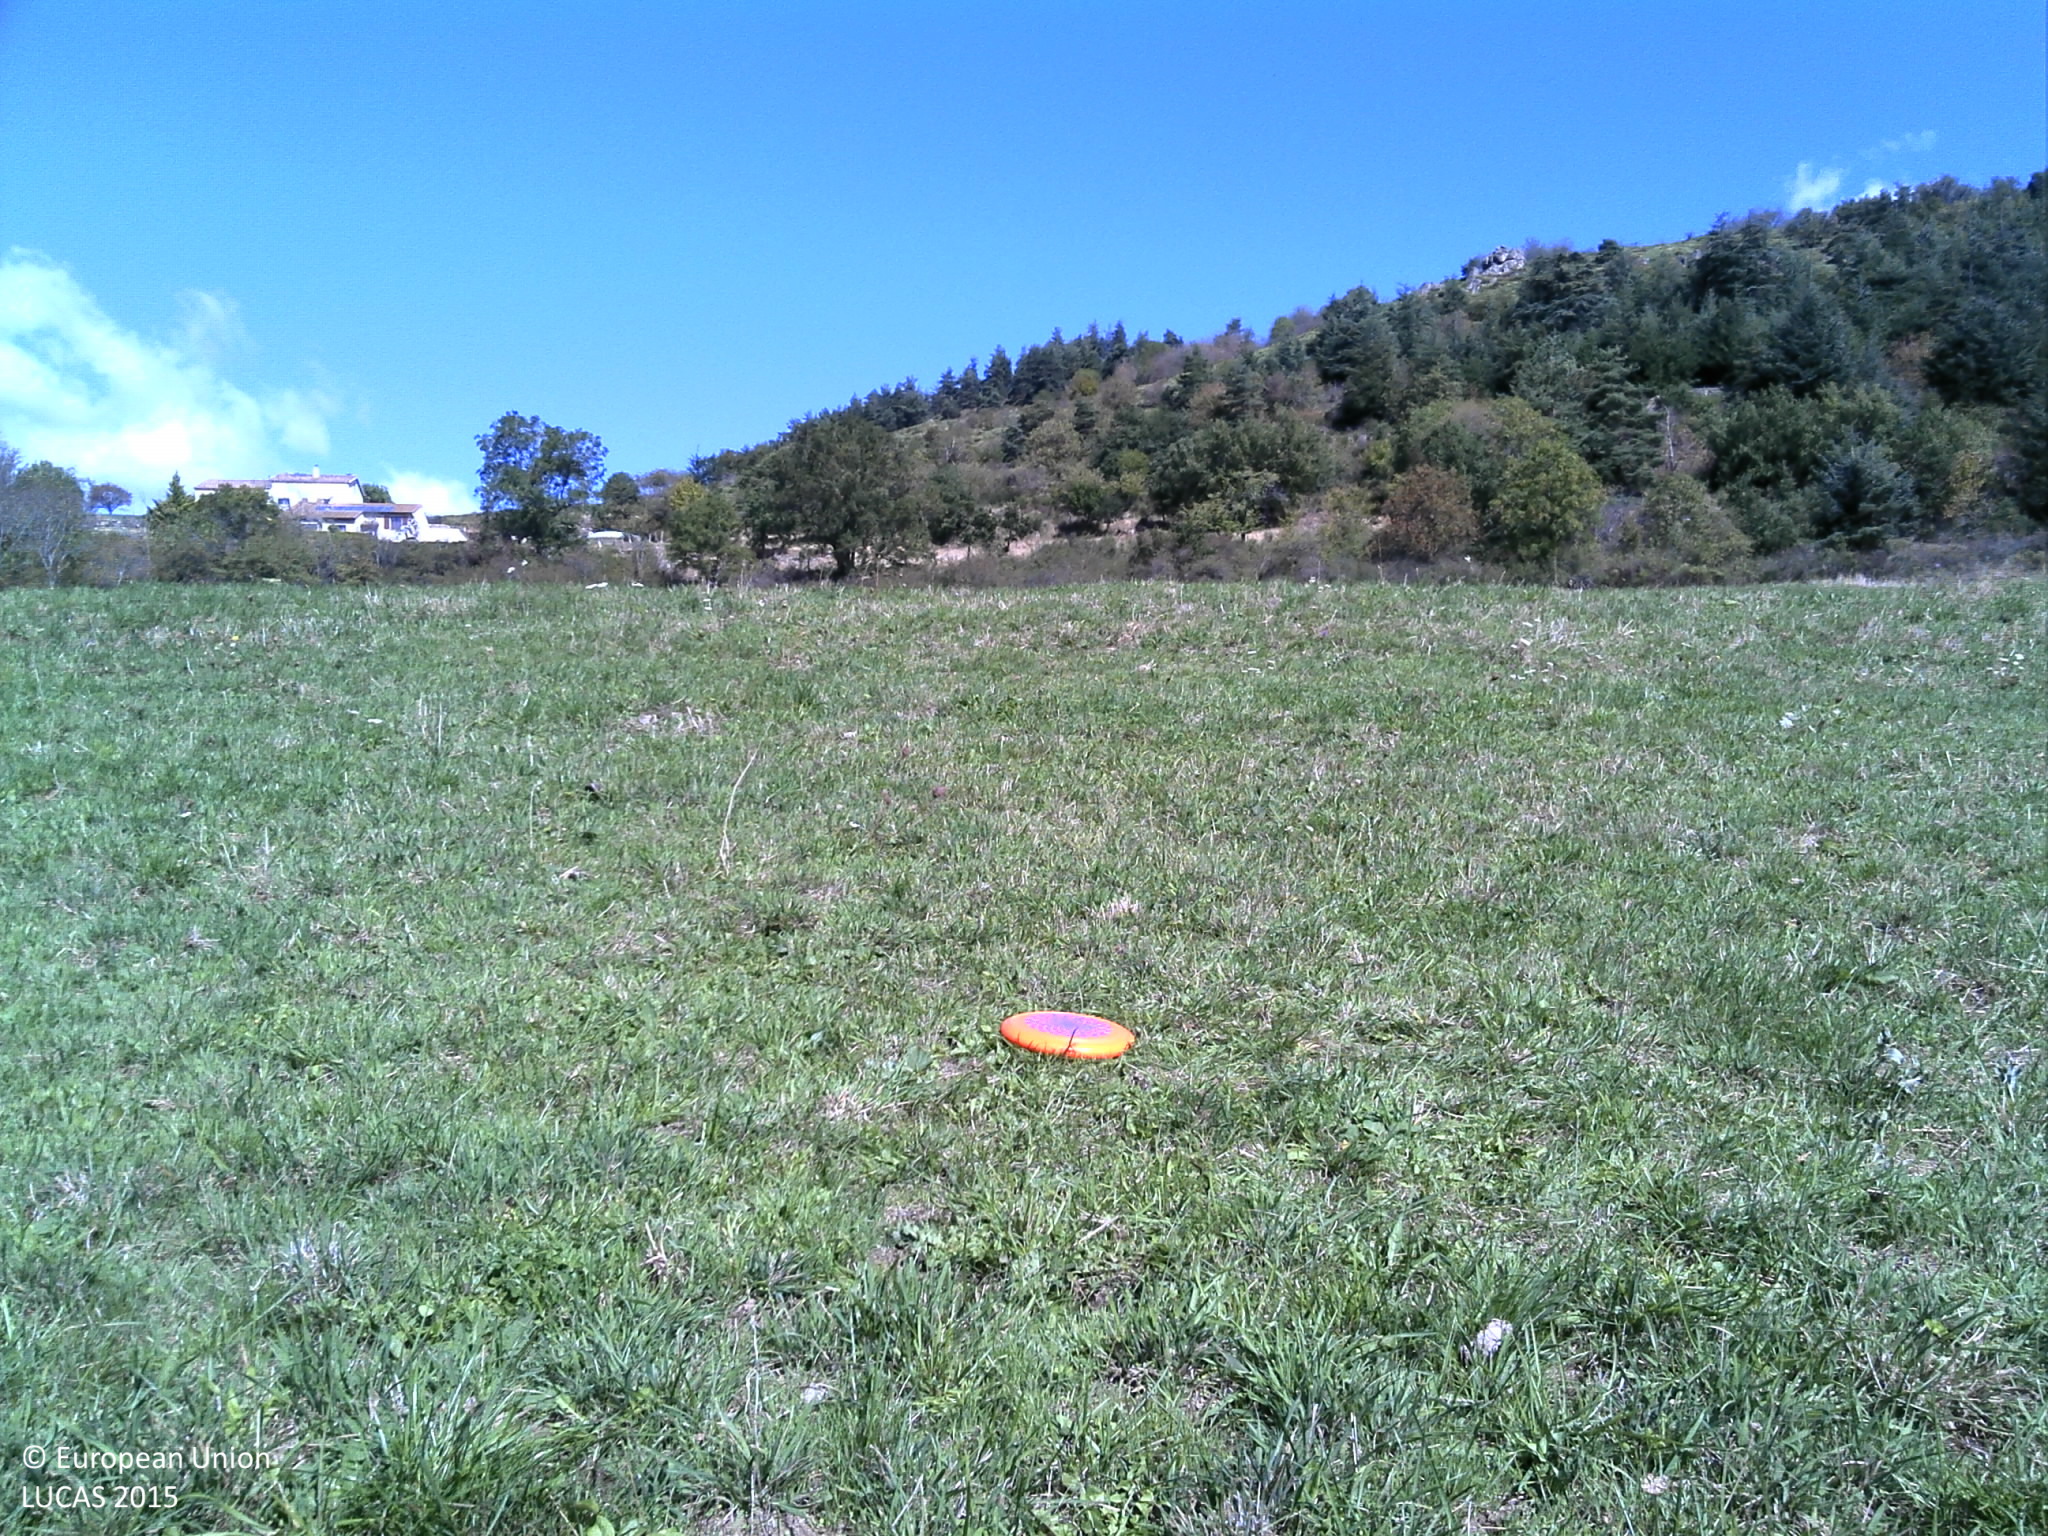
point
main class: Grassland
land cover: Grassland without tree/shrub cover
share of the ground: > 75 %
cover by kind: herbaceous plants 100 %
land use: Agriculture (excluding fallow land and kitchen gardens)
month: September
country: FR
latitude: 45.2380
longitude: 4.5652
